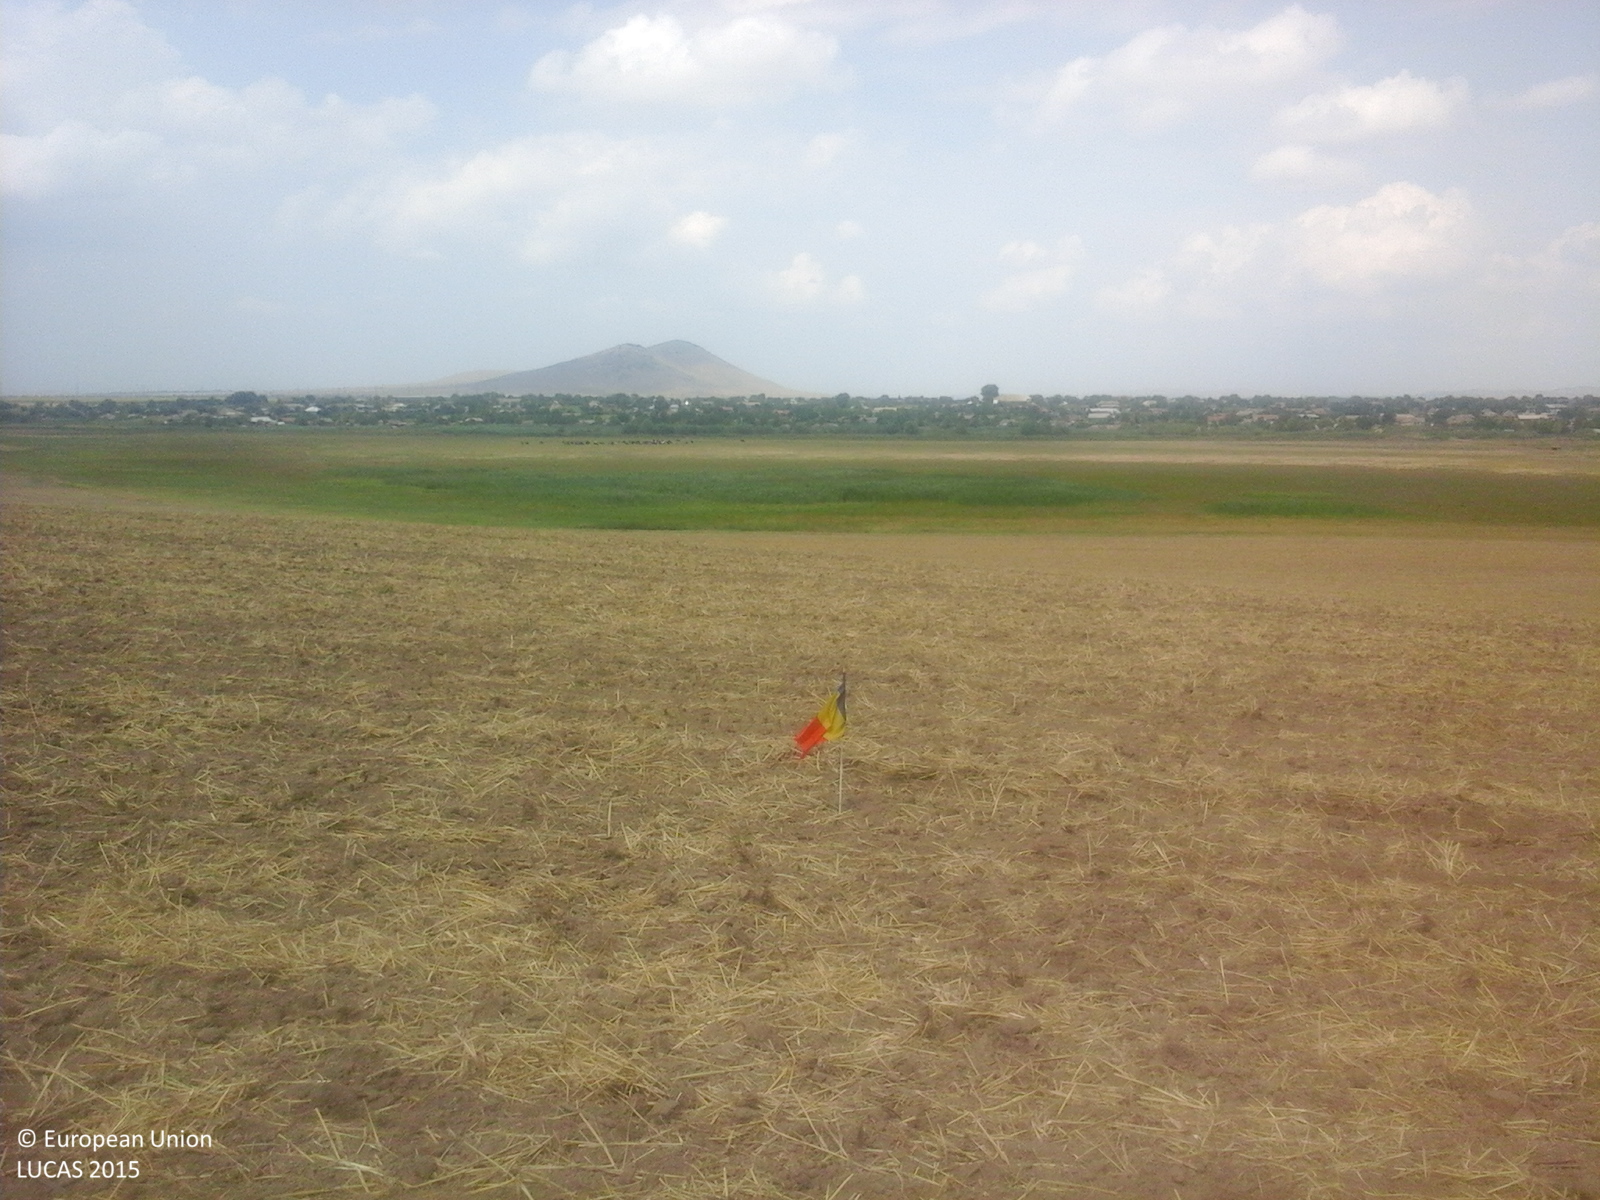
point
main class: Cropland
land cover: Common wheat
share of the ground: 10 - 25 %
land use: Agriculture (excluding fallow land and kitchen gardens)
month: July
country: RO
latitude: 44.9456
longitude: 28.6761
